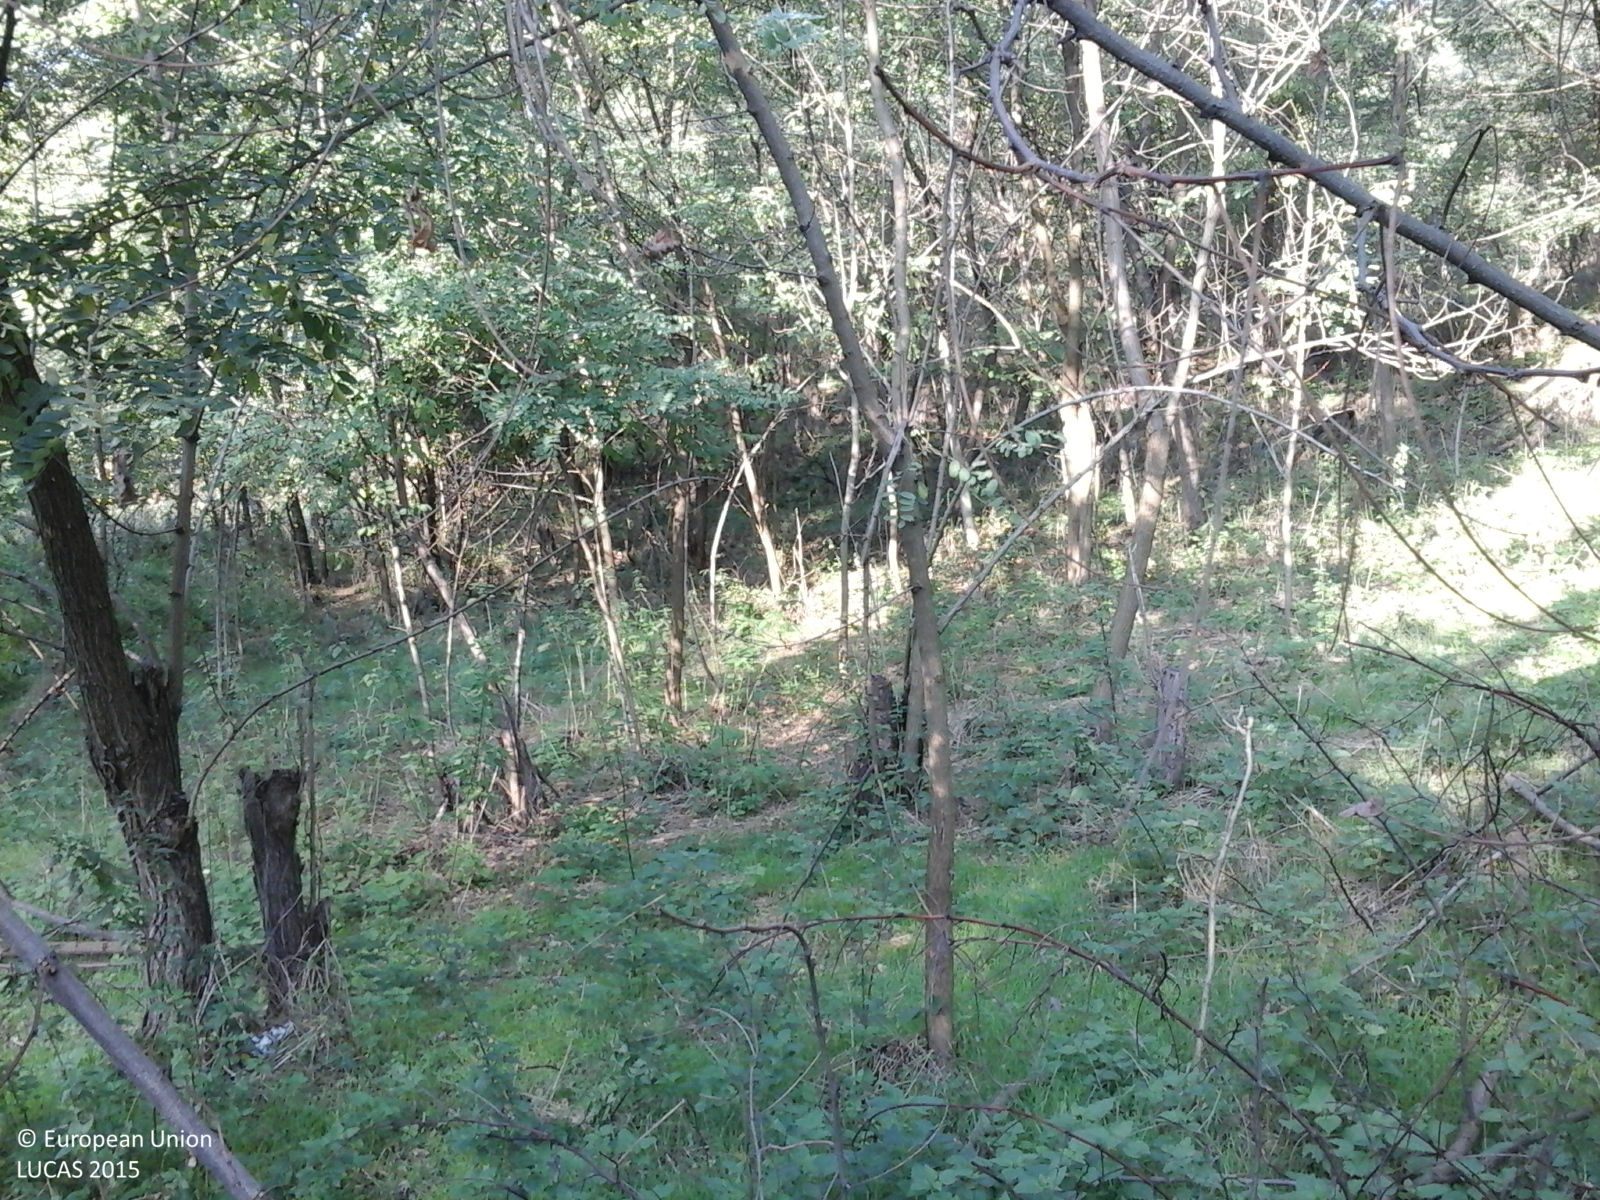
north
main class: Woodland
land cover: Broadleaved woodland
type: exotic forest
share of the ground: > 75 %
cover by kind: broadleaved forest trees 100 %
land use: Forestry
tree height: > 5 m
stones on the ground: < 10 %
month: October
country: RO
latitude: 46.0763
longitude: 24.1844
